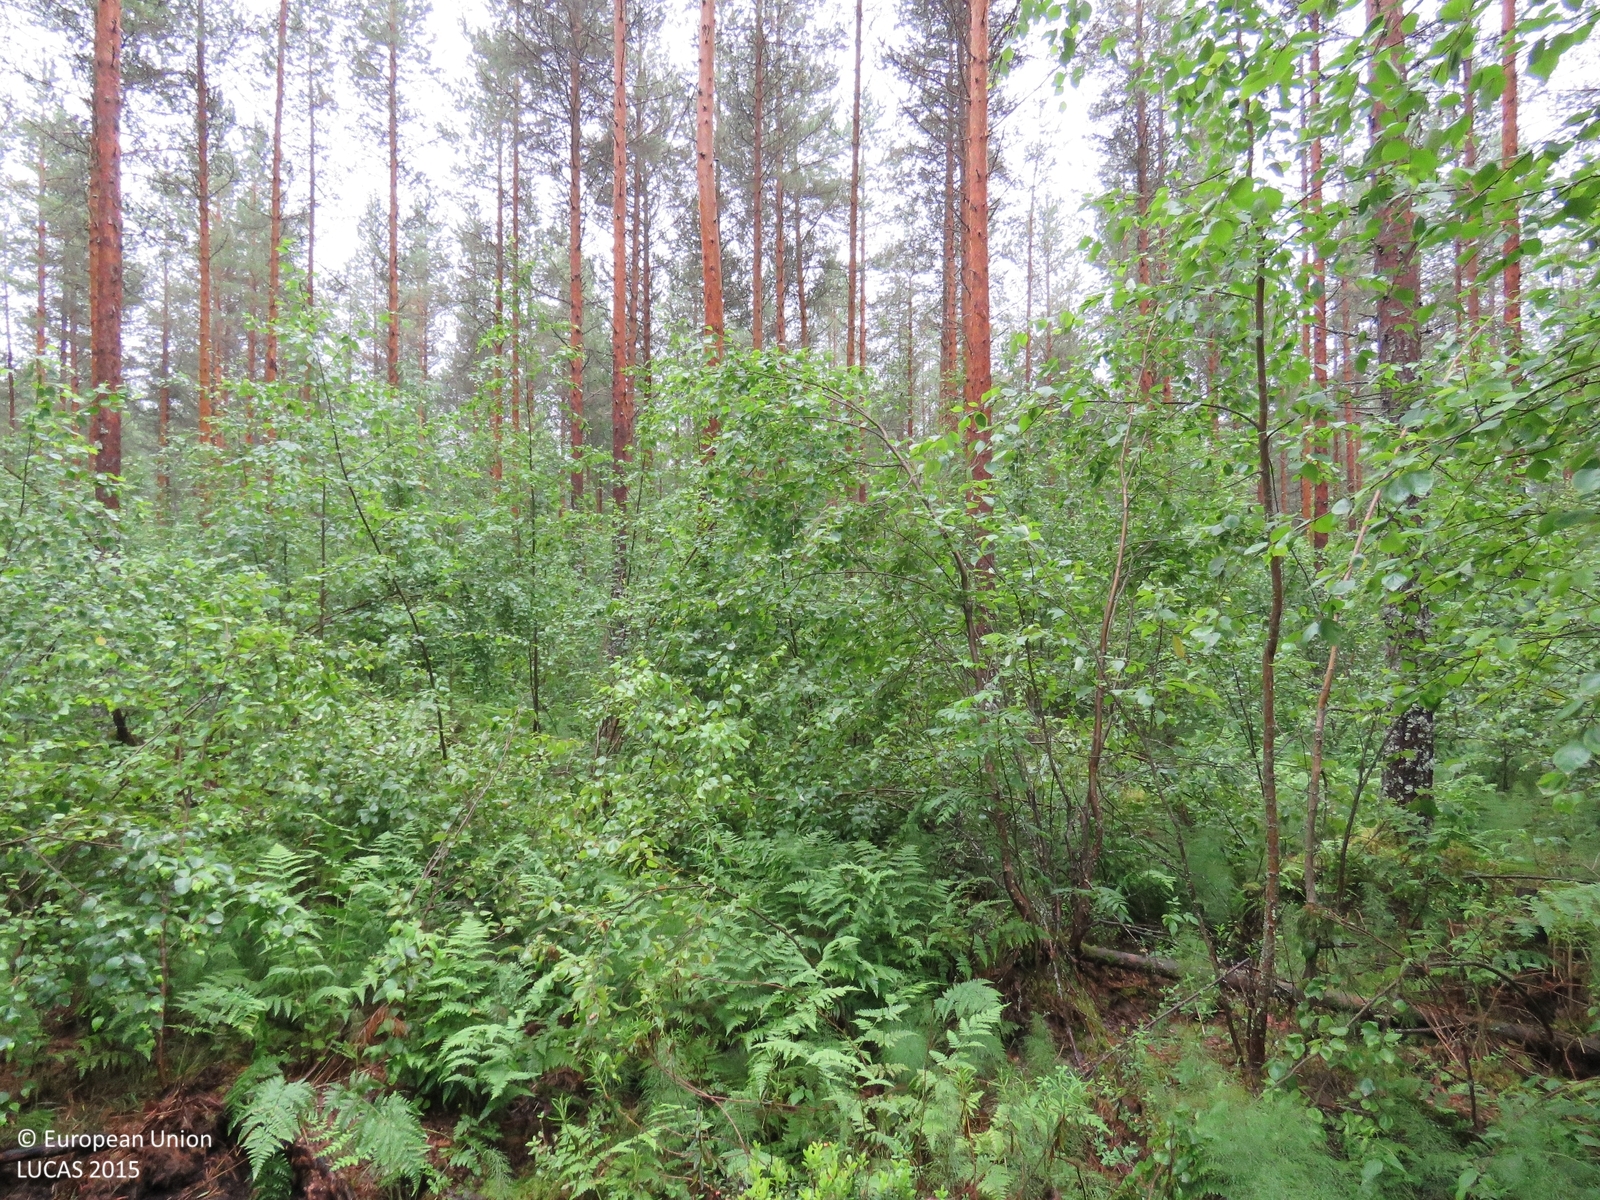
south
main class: Woodland
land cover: Pine dominated mixed woodland
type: boreal forest
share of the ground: > 75 %
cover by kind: coniferous forest trees 50 %, broadleaved forest trees 40 %, herbaceous plants 10 %
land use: Forestry
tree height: > 5 m
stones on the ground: < 10 %
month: July
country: FI
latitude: 64.3387
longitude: 26.8703
